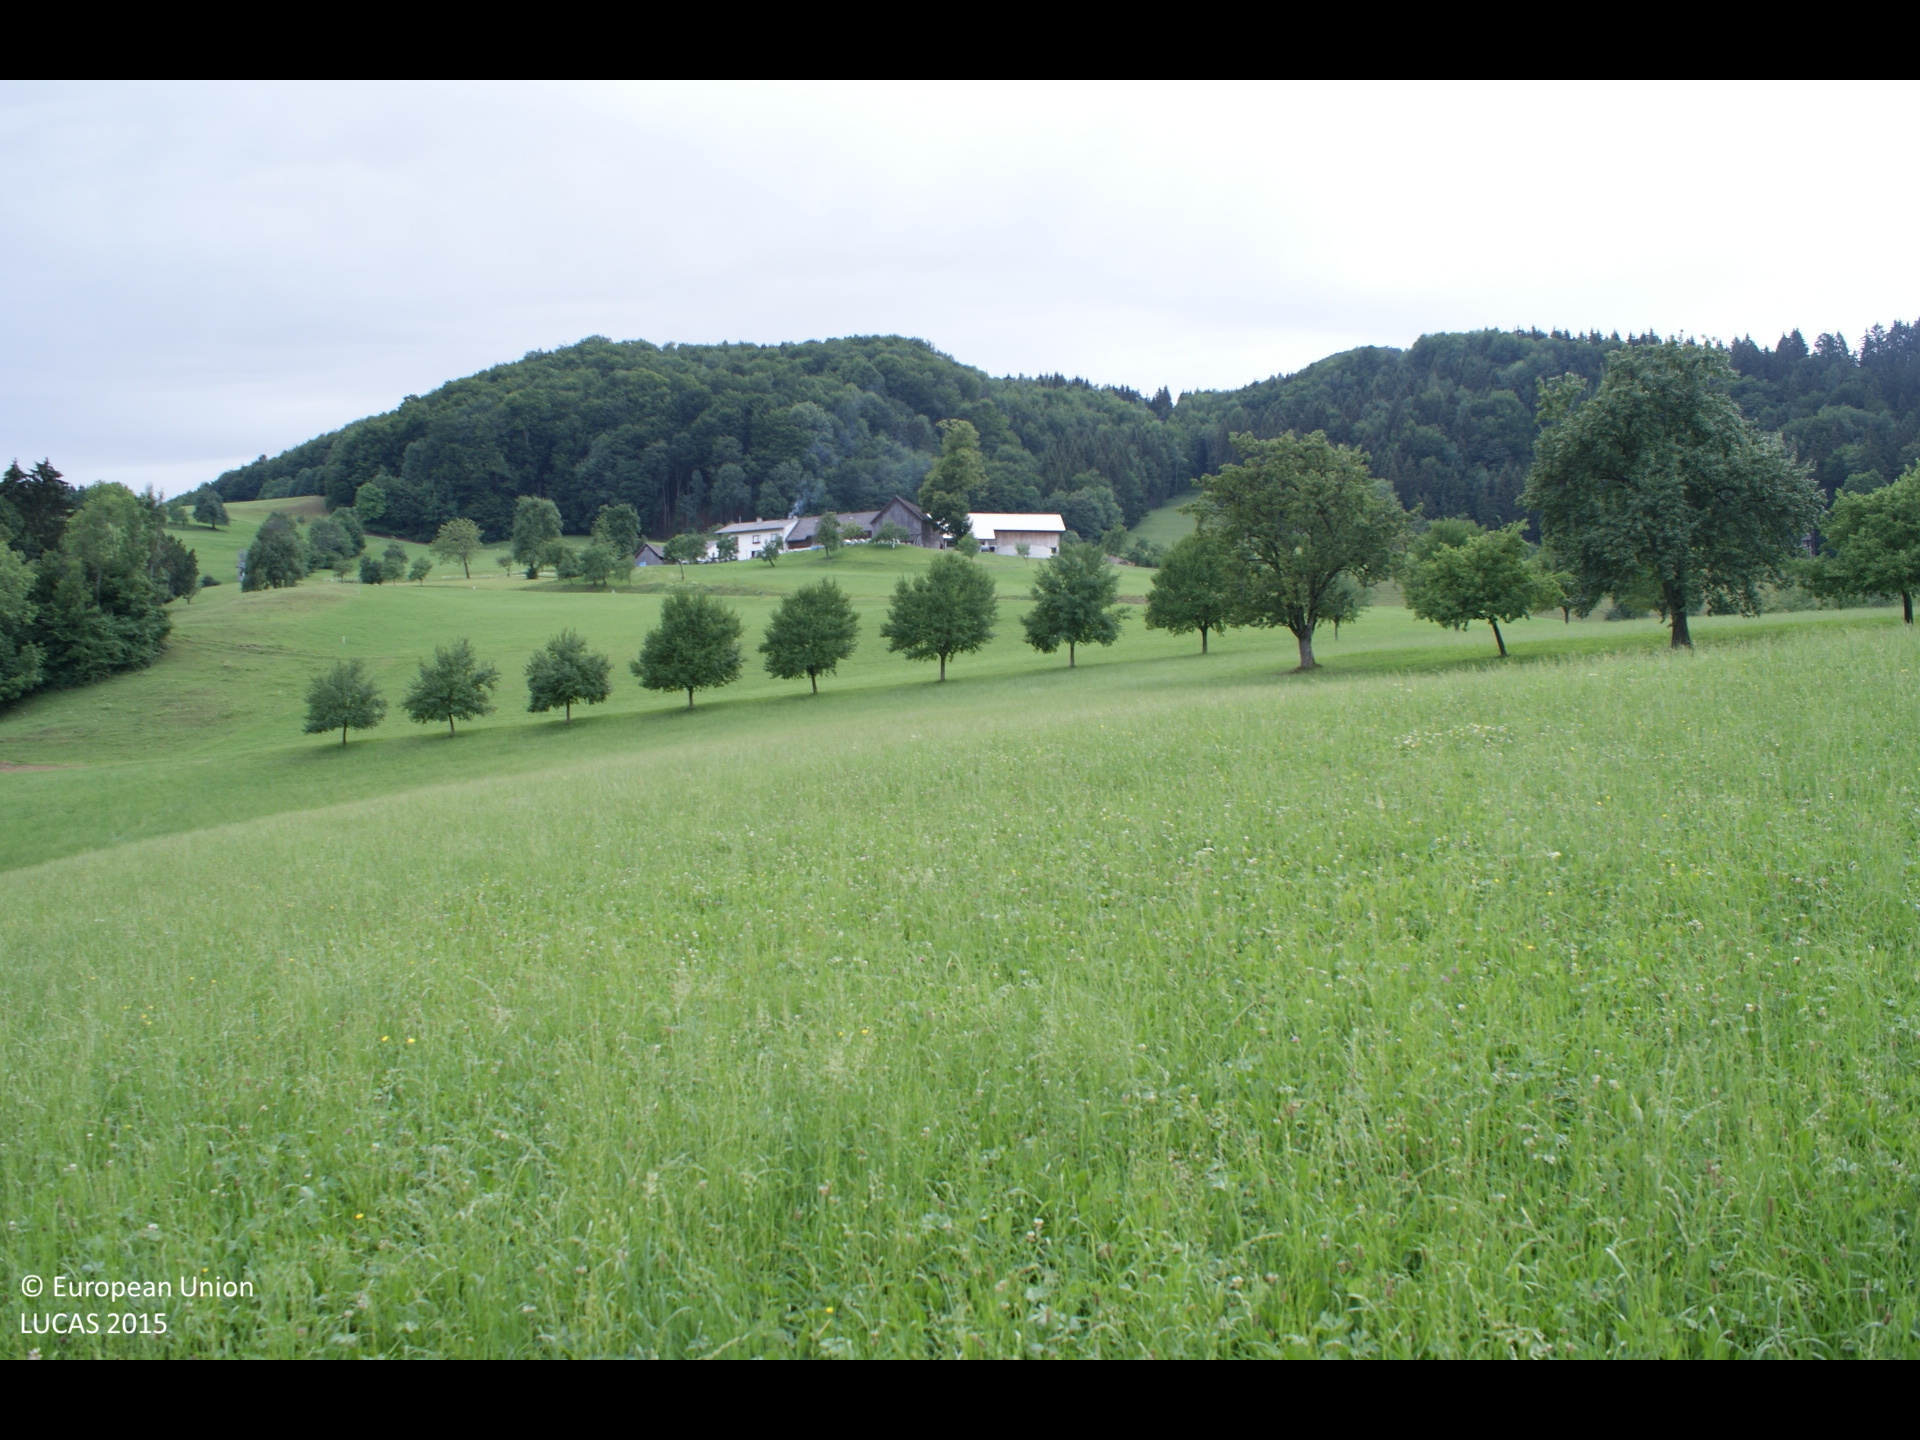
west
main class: Grassland
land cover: Grassland without tree/shrub cover
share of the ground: > 75 %
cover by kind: herbaceous plants 100 %
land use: Agriculture (excluding fallow land and kitchen gardens)
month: July
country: AT
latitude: 47.9469
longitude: 15.0216
